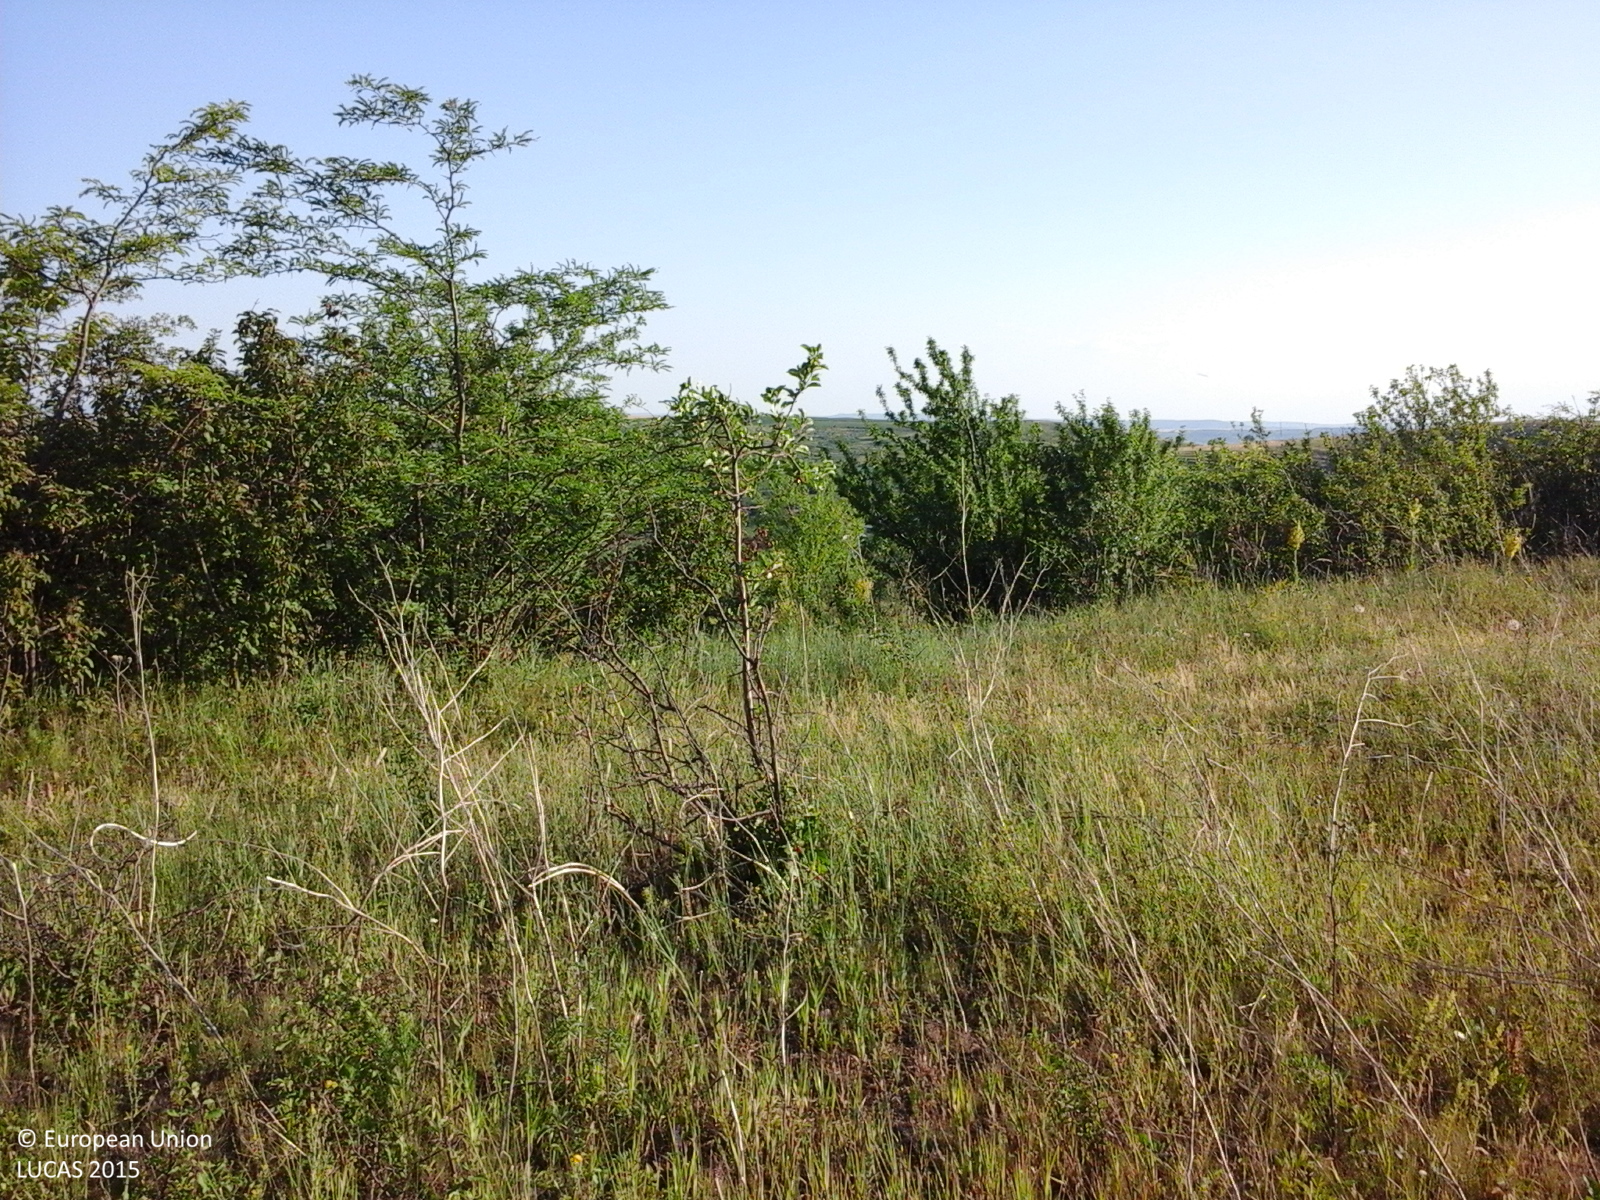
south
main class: Shrubland
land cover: Shrubland with sparse tree cover
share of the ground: > 75 %
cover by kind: herbaceous plants 50 %, shrubs 45 %, broadleaved forest trees 5 %
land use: Agriculture (excluding fallow land and kitchen gardens)
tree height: < 5 m
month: June
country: RO
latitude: 46.9305
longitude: 27.5444
